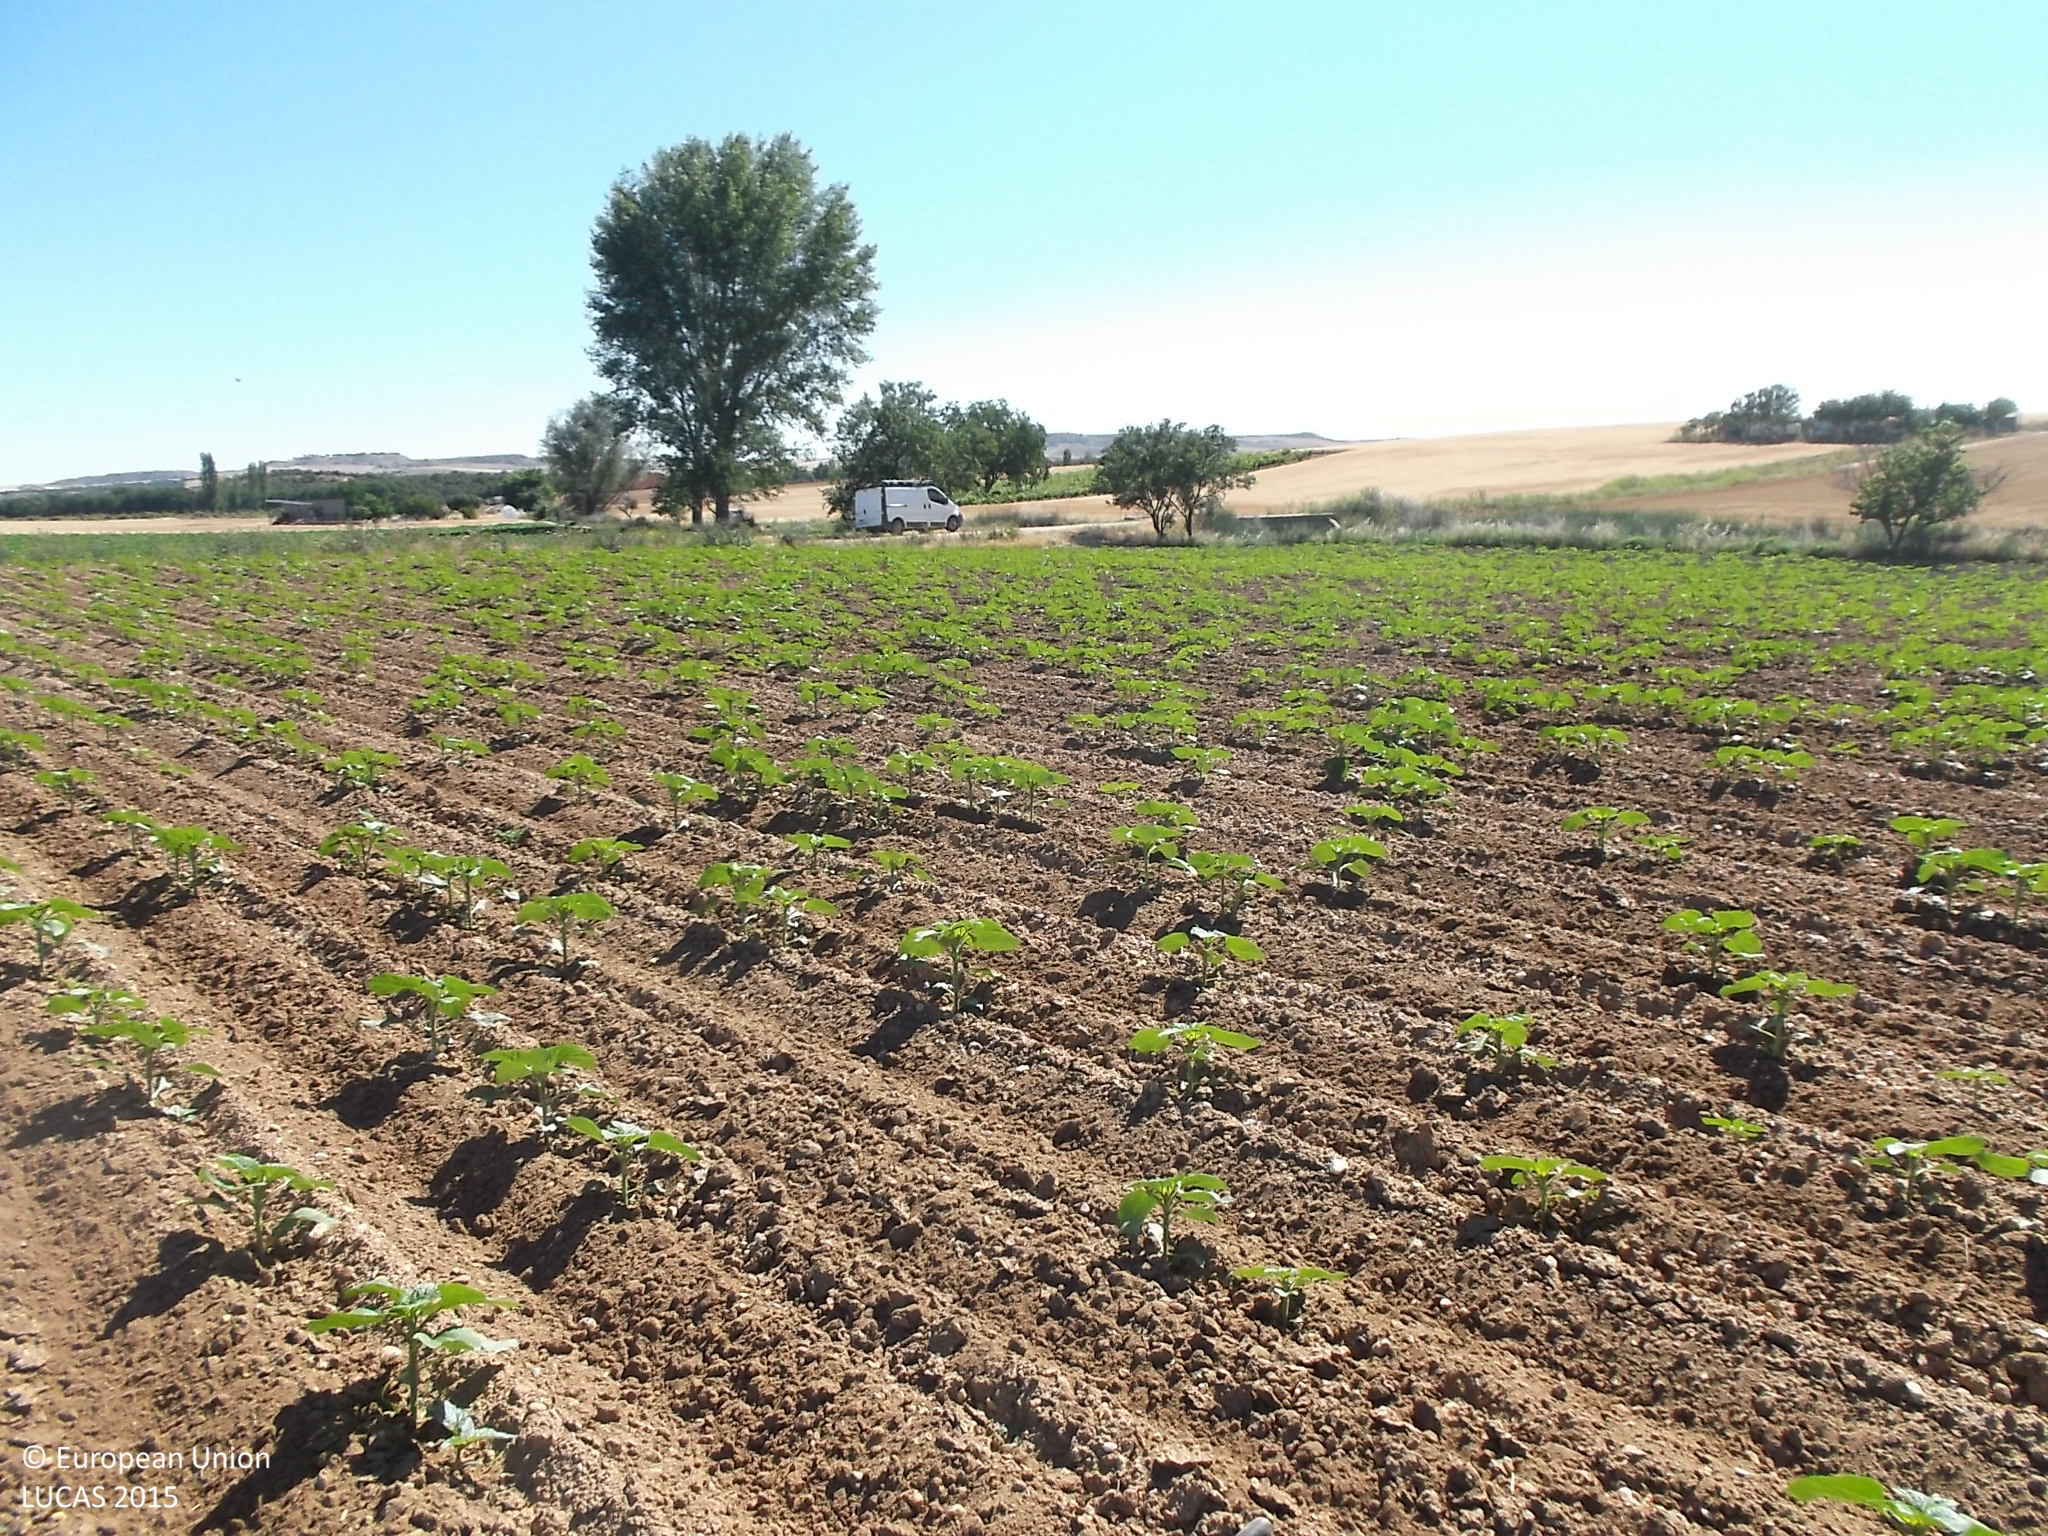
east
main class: Cropland
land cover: Sunflower
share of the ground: 50 - 75 %
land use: Agriculture (excluding fallow land and kitchen gardens)
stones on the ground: < 10 %
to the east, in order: Sunflower; Single bushes/trees; Ditches and canals; Common wheat; Grass margins; Tracks; Grass margins; Barley; Grass margins; Fences; Artificial constructions in urban areas; Fences; Grass margins; Barley
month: June
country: ES
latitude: 41.2535
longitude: -5.3634
